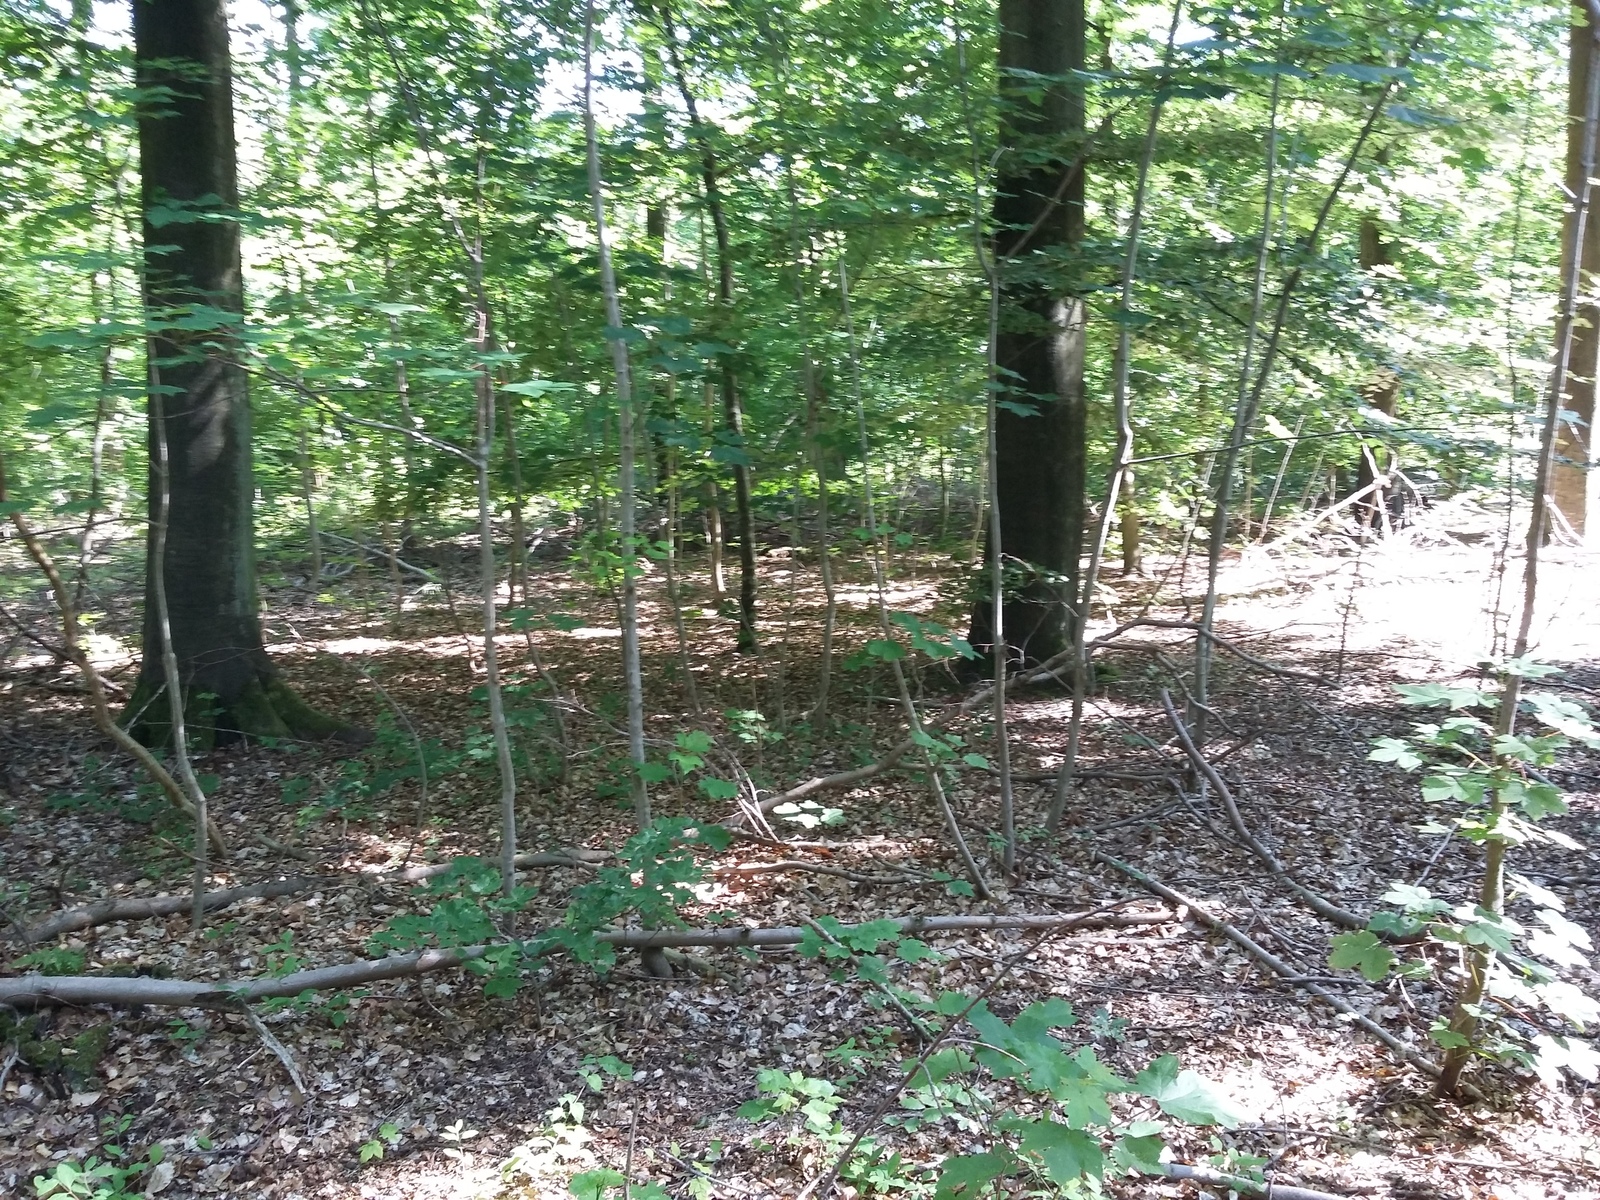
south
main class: Woodland
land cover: Broadleaved woodland
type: beech forest
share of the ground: > 75 %
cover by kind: broadleaved forest trees 80 %, herbaceous plants 20 %
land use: Forestry
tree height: > 5 m
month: June
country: DK
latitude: 54.8255
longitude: 11.8822
